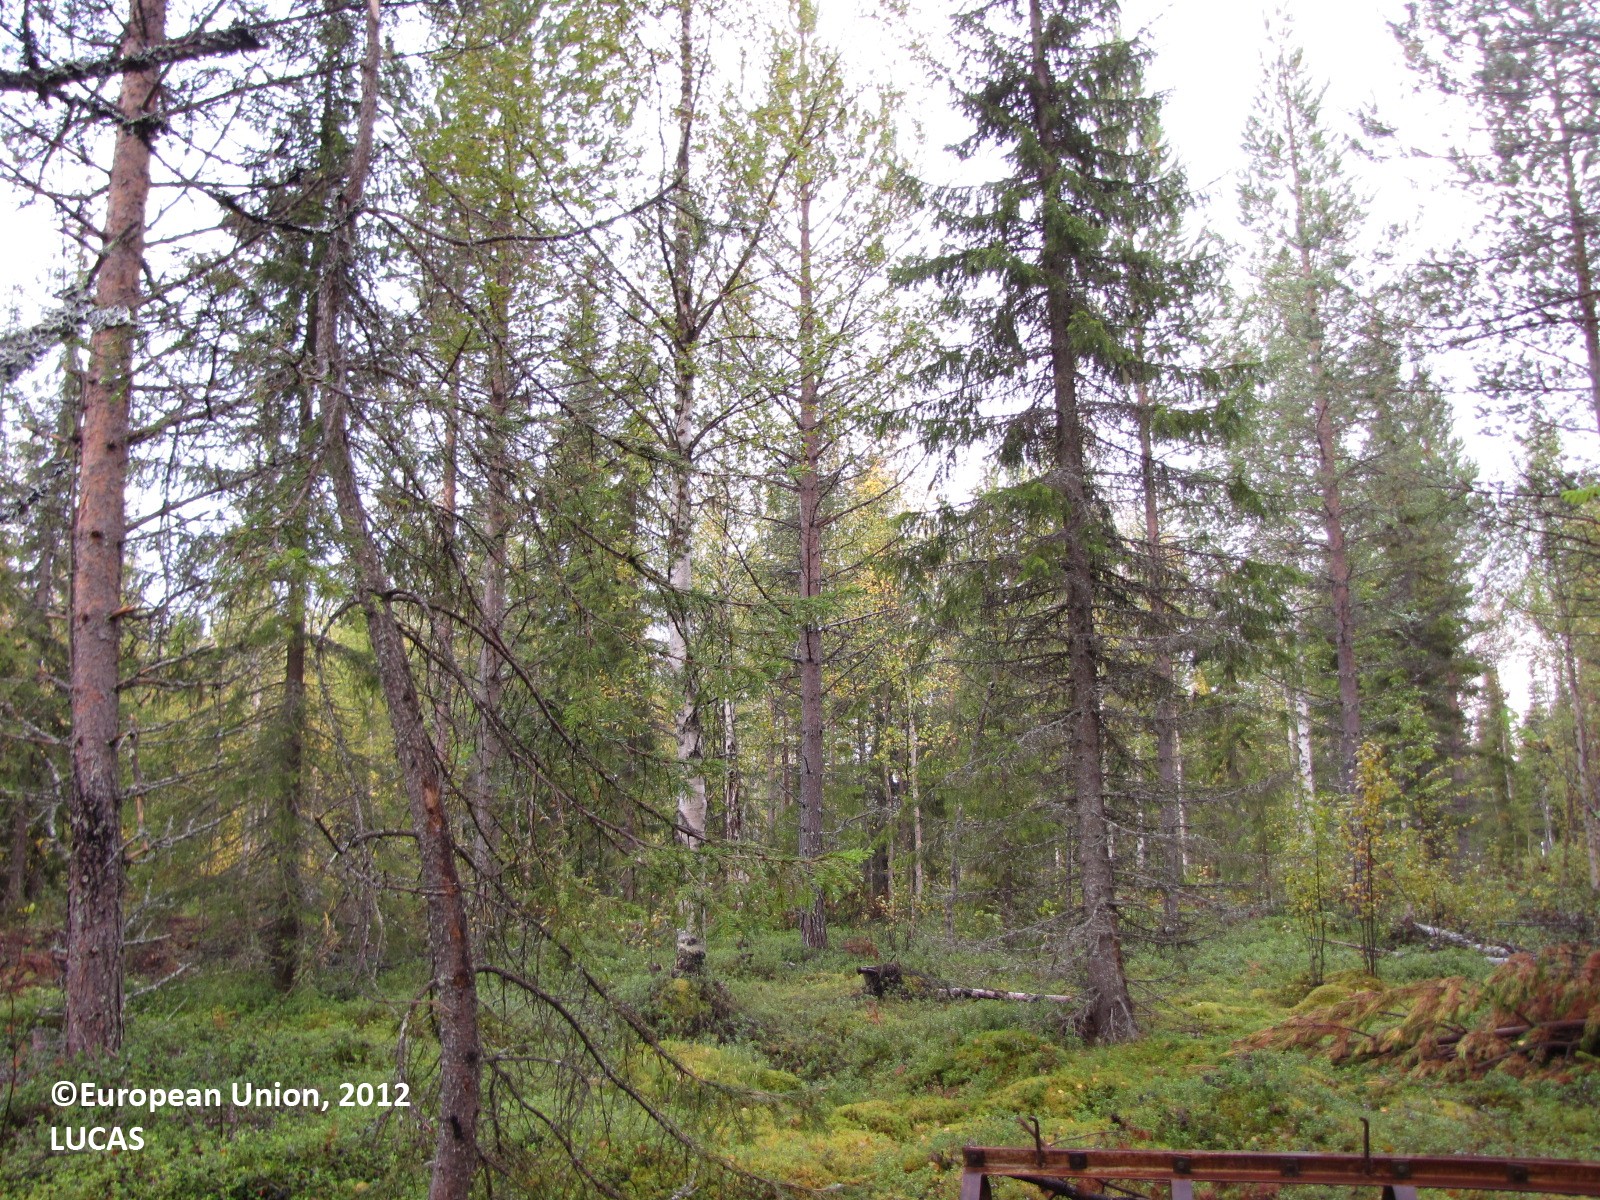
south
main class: Woodland
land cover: Other mixed woodland
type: boreal forest
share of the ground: 10 - 25 %
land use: Forestry
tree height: > 5 m
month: September
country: FI
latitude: 67.2689
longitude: 23.8692
